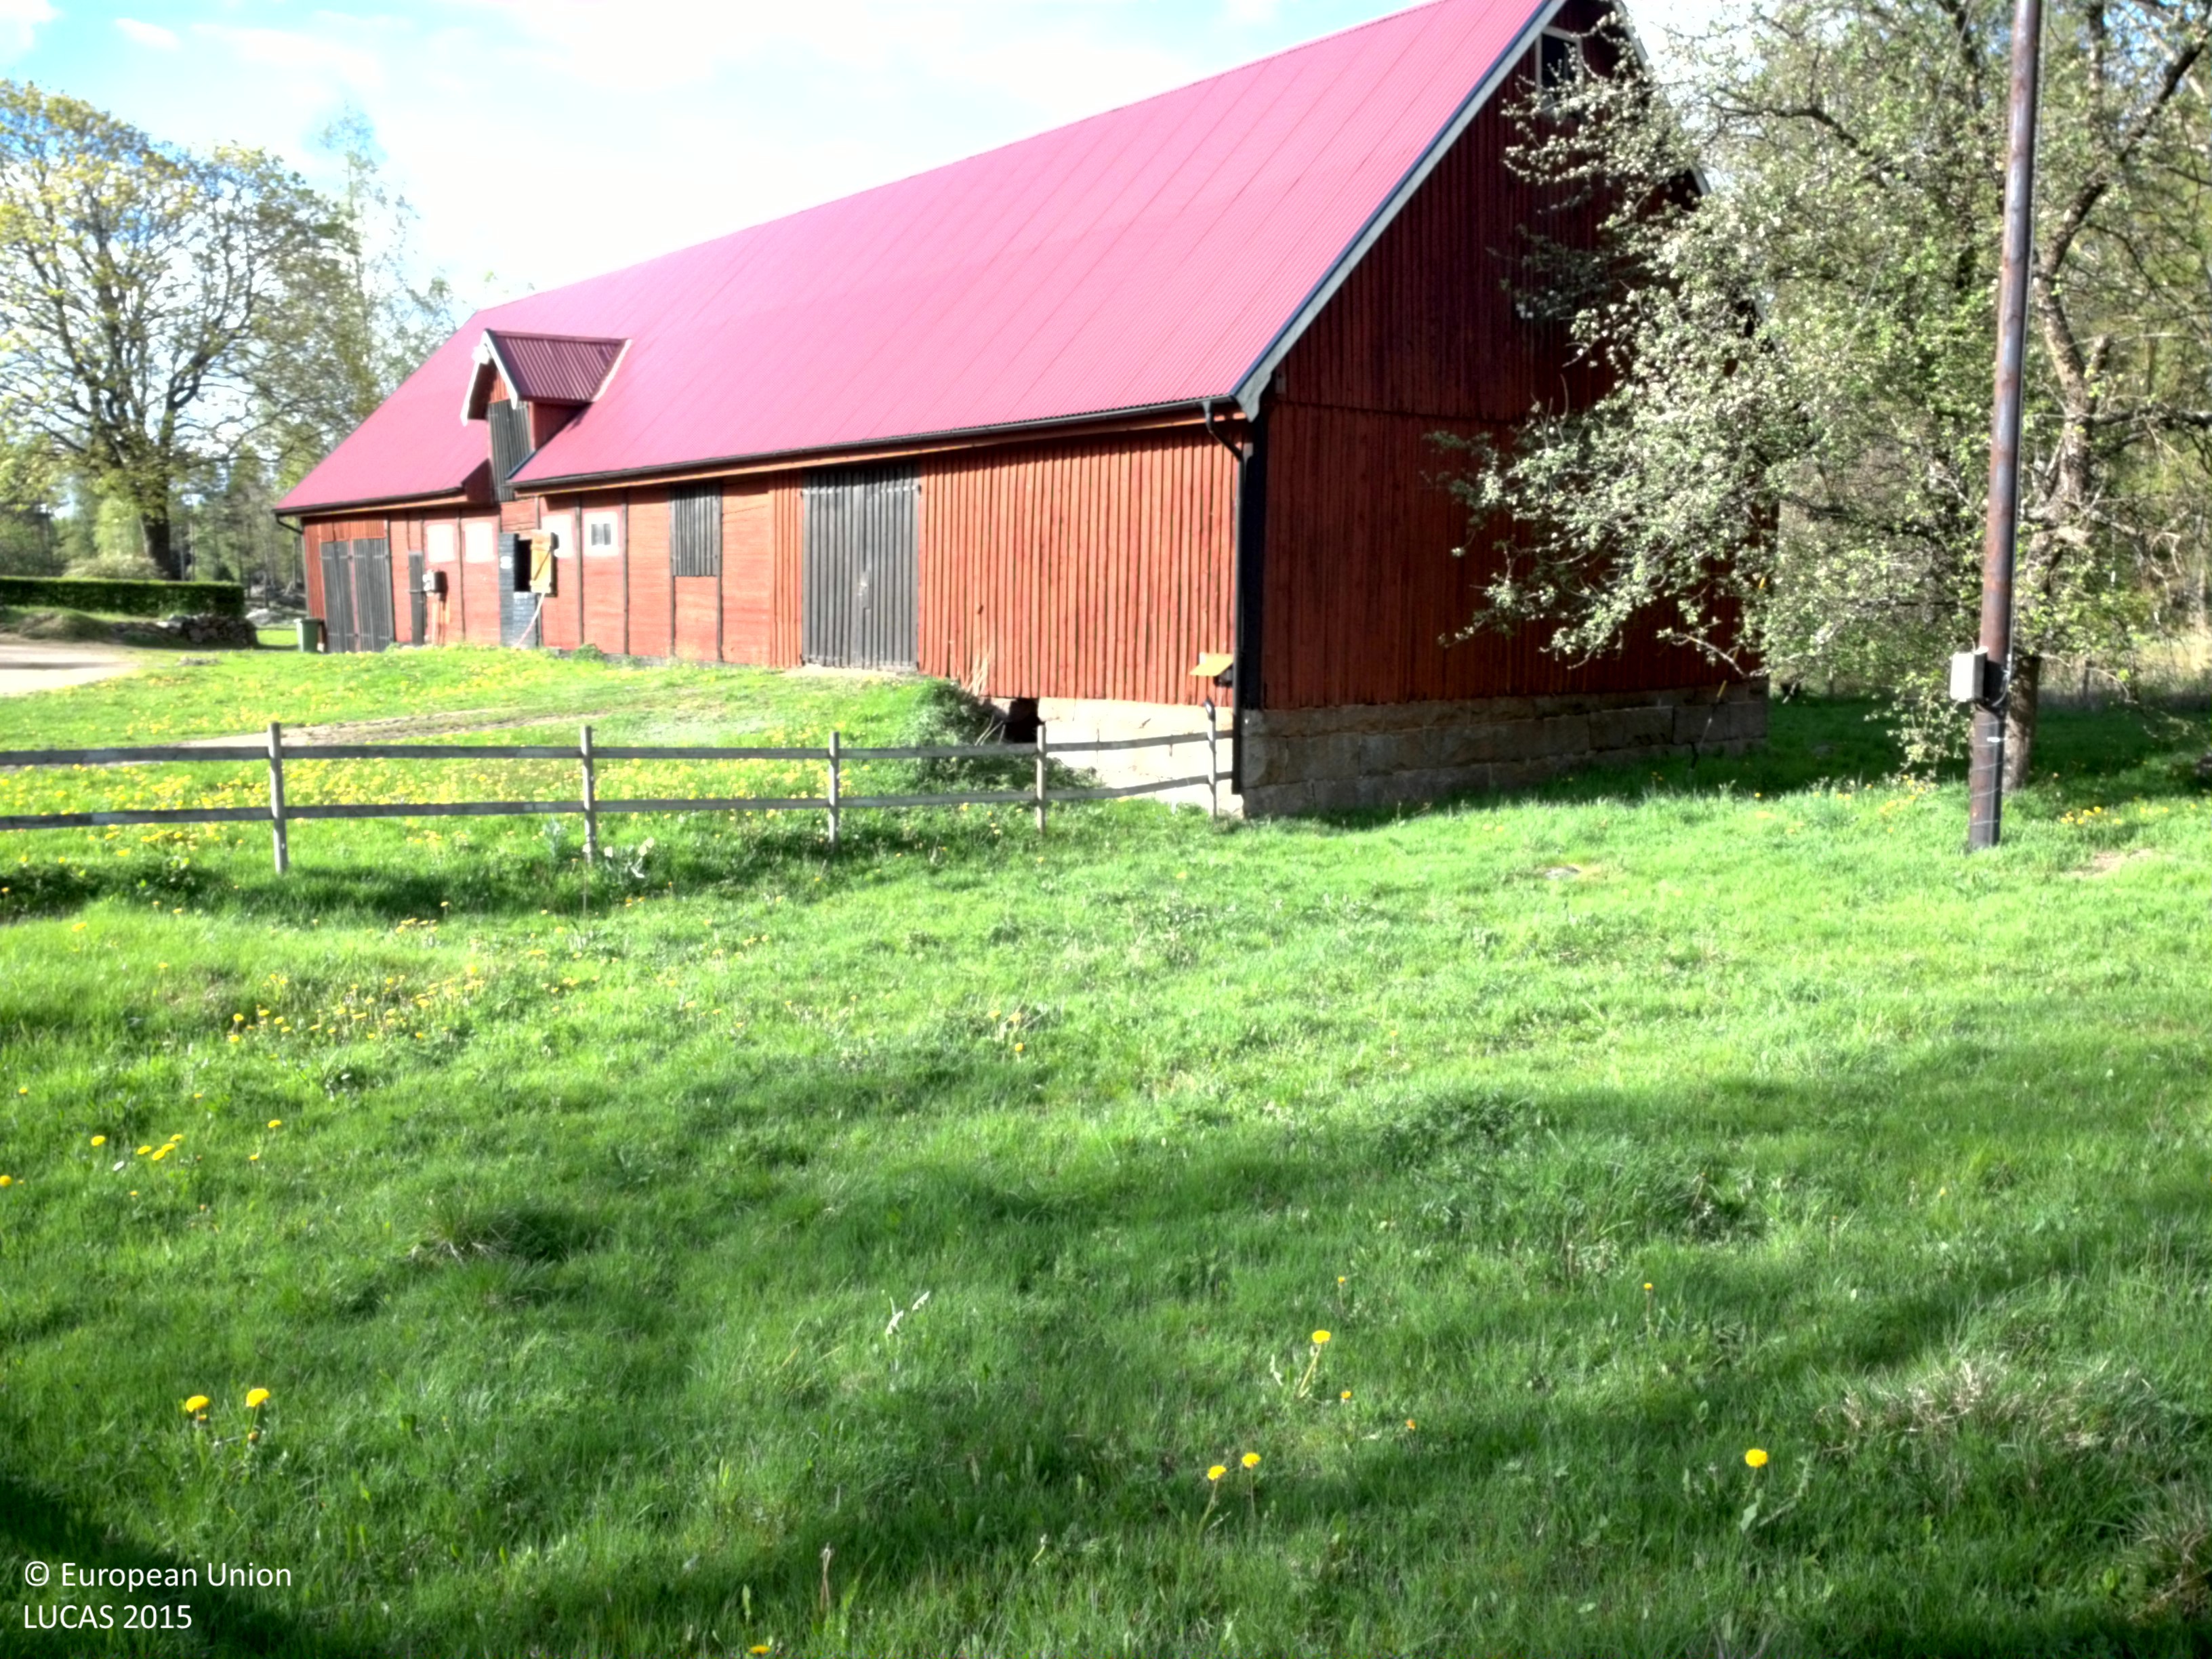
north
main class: Grassland
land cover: Grassland without tree/shrub cover
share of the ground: > 75 %
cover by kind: herbaceous plants 100 %
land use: Agriculture (excluding fallow land and kitchen gardens)
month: May
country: SE
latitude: 56.4028
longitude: 15.2975
